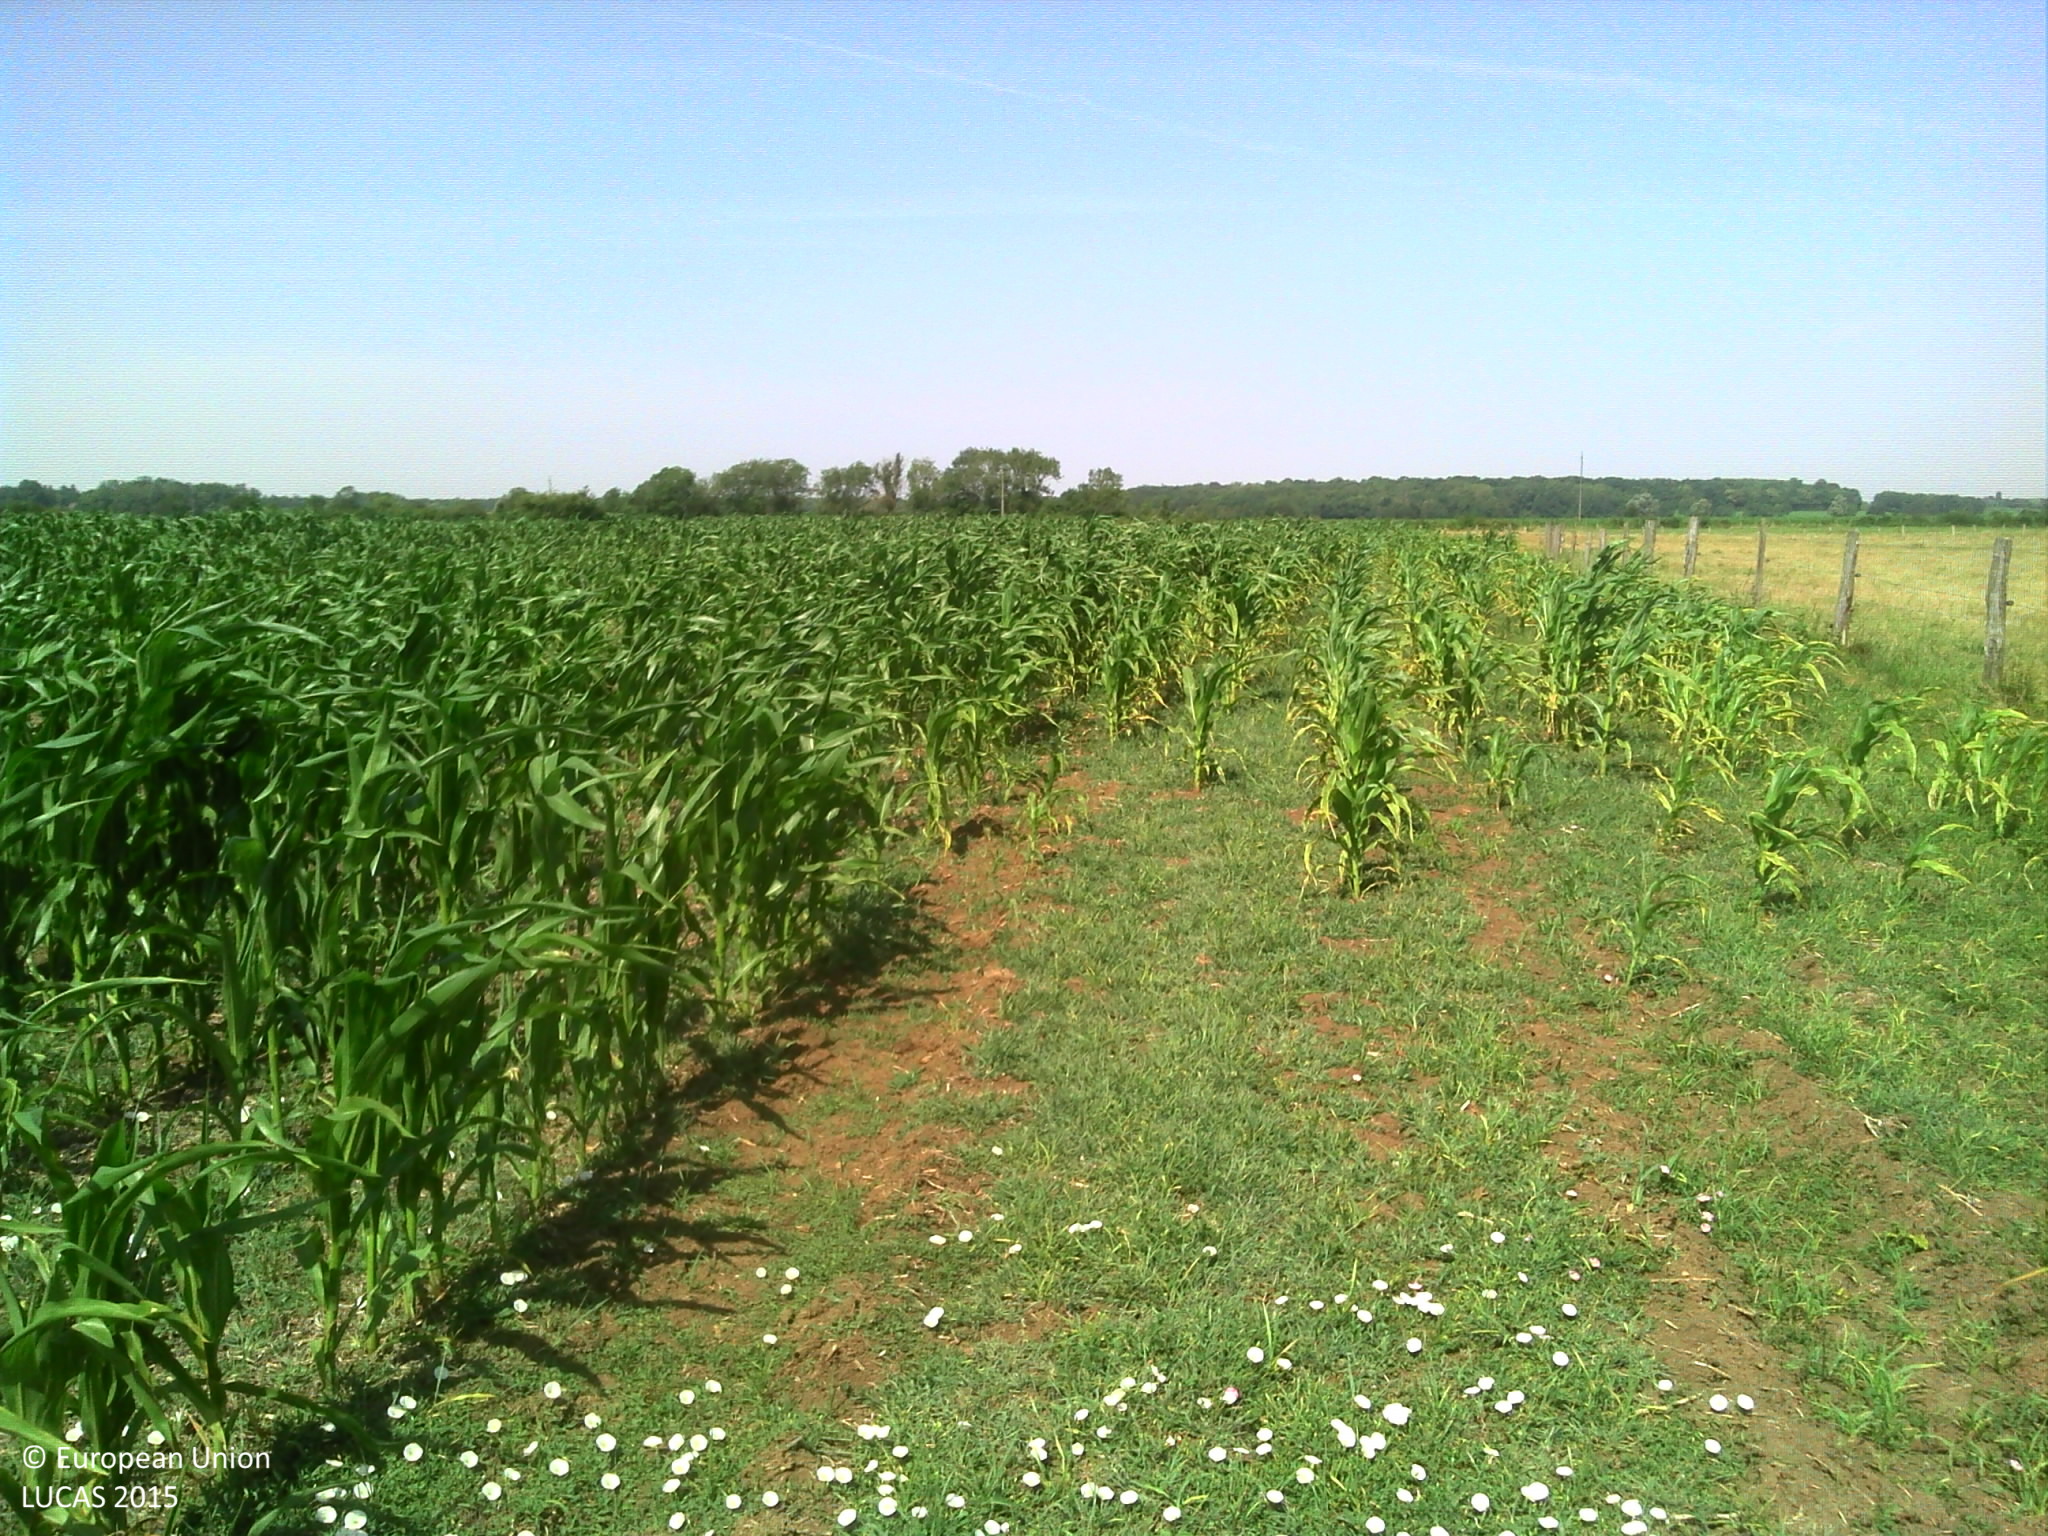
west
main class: Cropland
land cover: Maize
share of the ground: 50 - 75 %
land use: Agriculture (excluding fallow land and kitchen gardens)
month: July
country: FR
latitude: 46.8946
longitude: 5.2371
